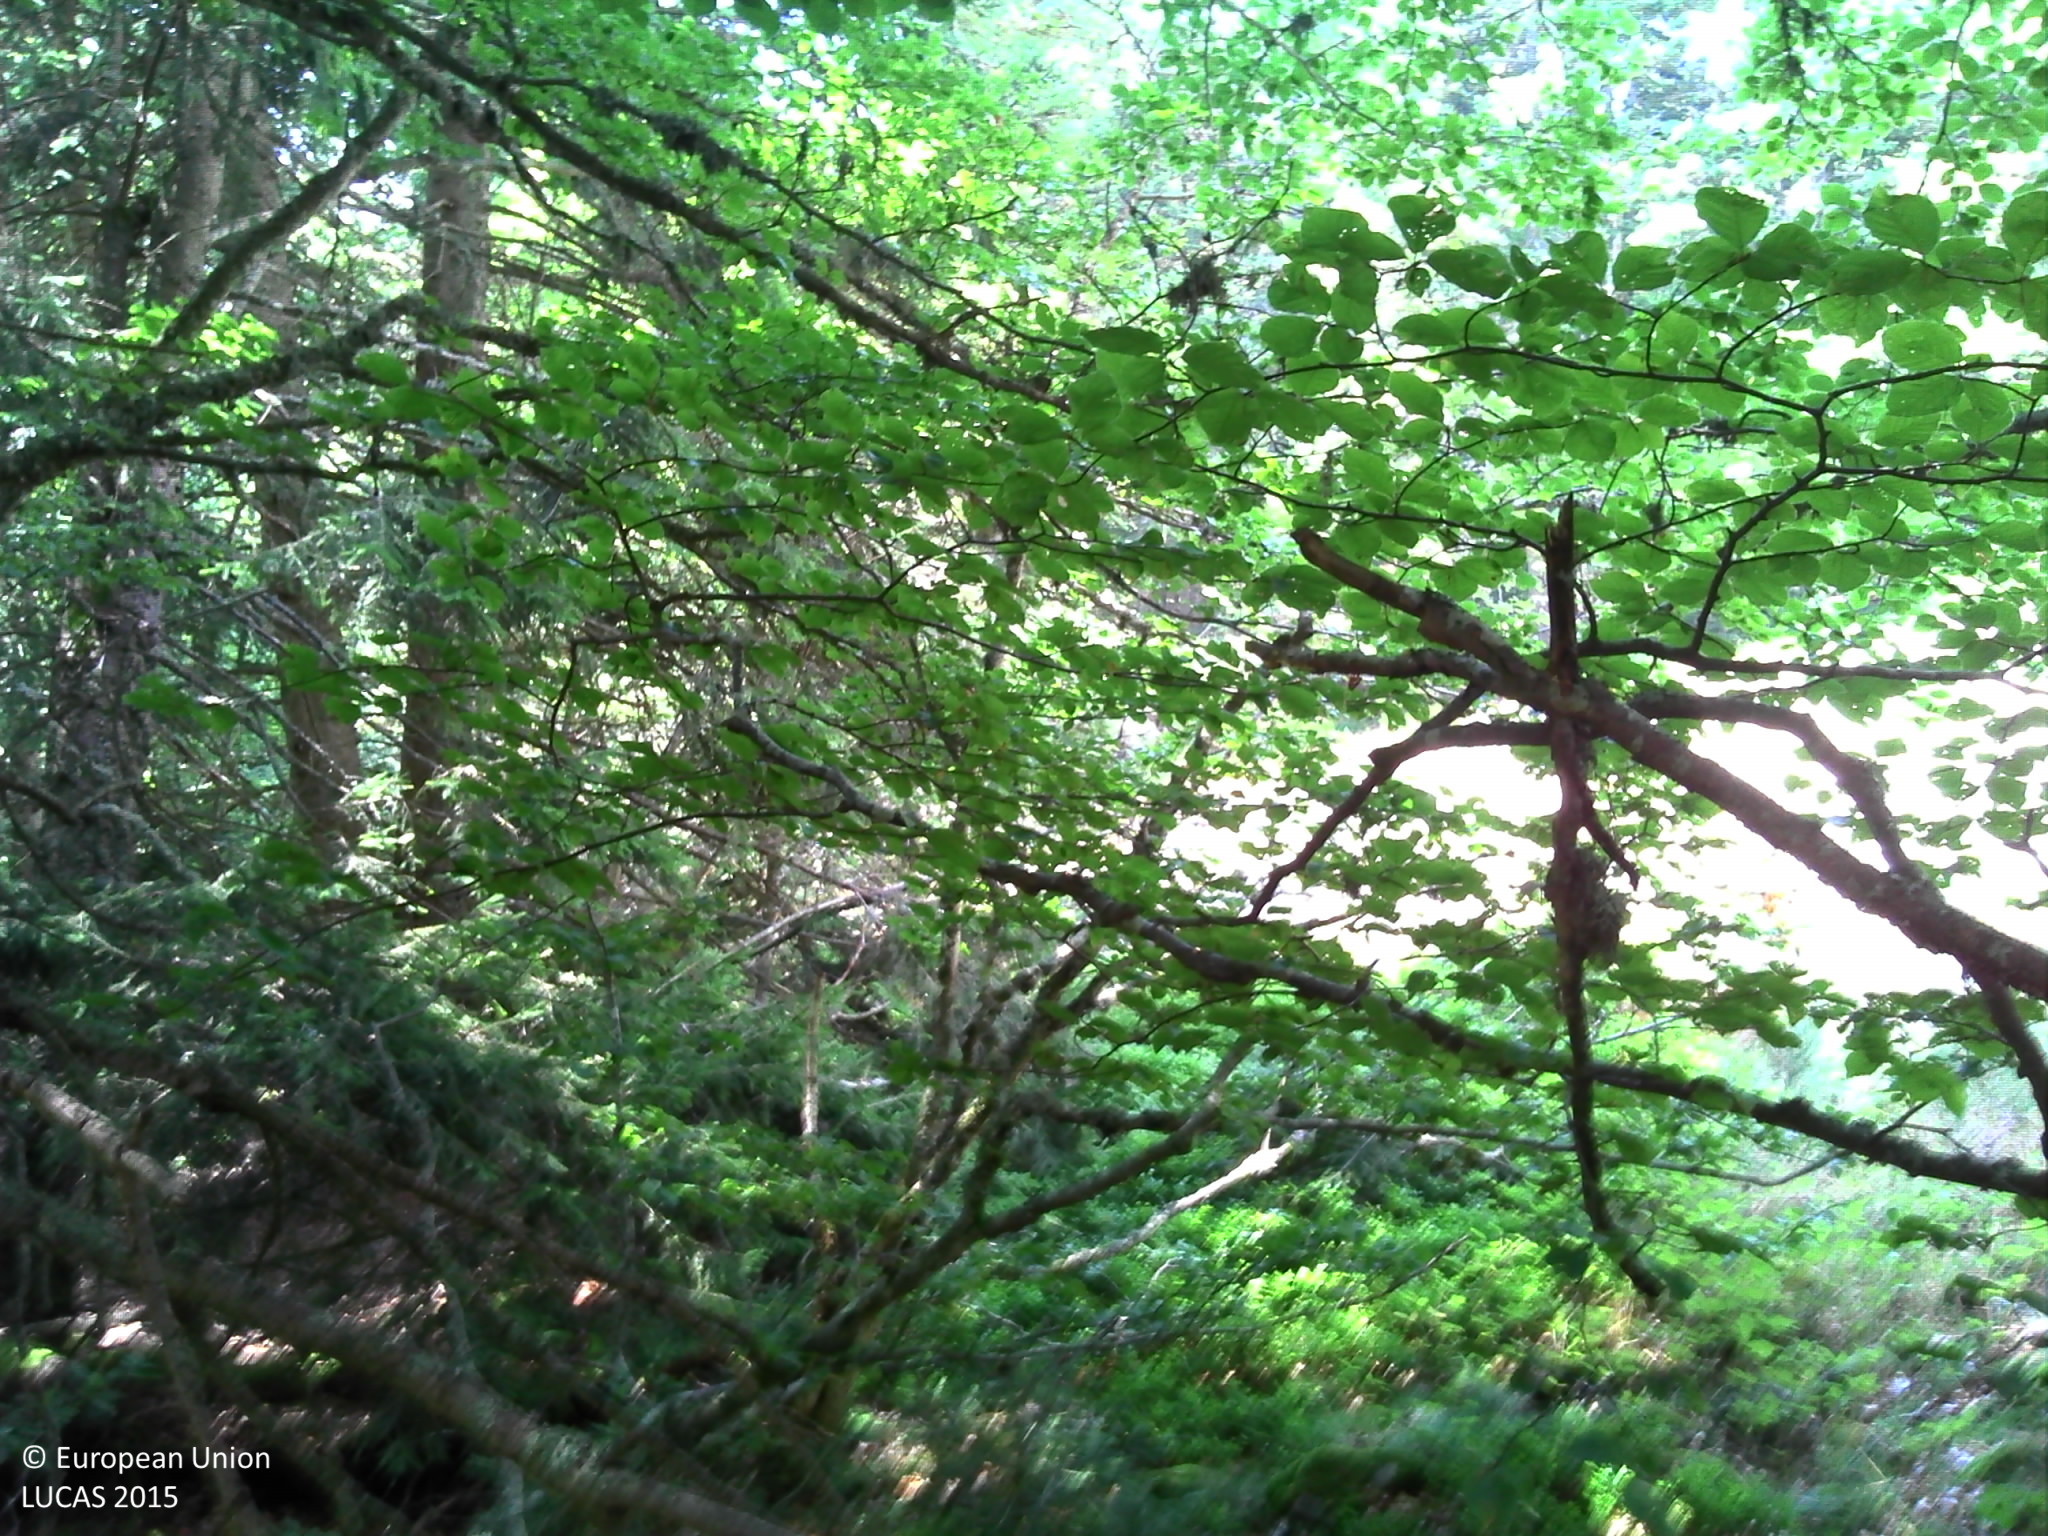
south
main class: Woodland
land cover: Spruce dominated mixed woodland
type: mountainous beech forest
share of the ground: > 75 %
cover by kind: coniferous forest trees 35 %, broadleaved forest trees 35 %, shrubs 10 %, herbaceous plants 10 %, lichens and mosses 10 %
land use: Forestry
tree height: > 5 m
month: August
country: FR
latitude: 45.3844
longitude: 4.6019
